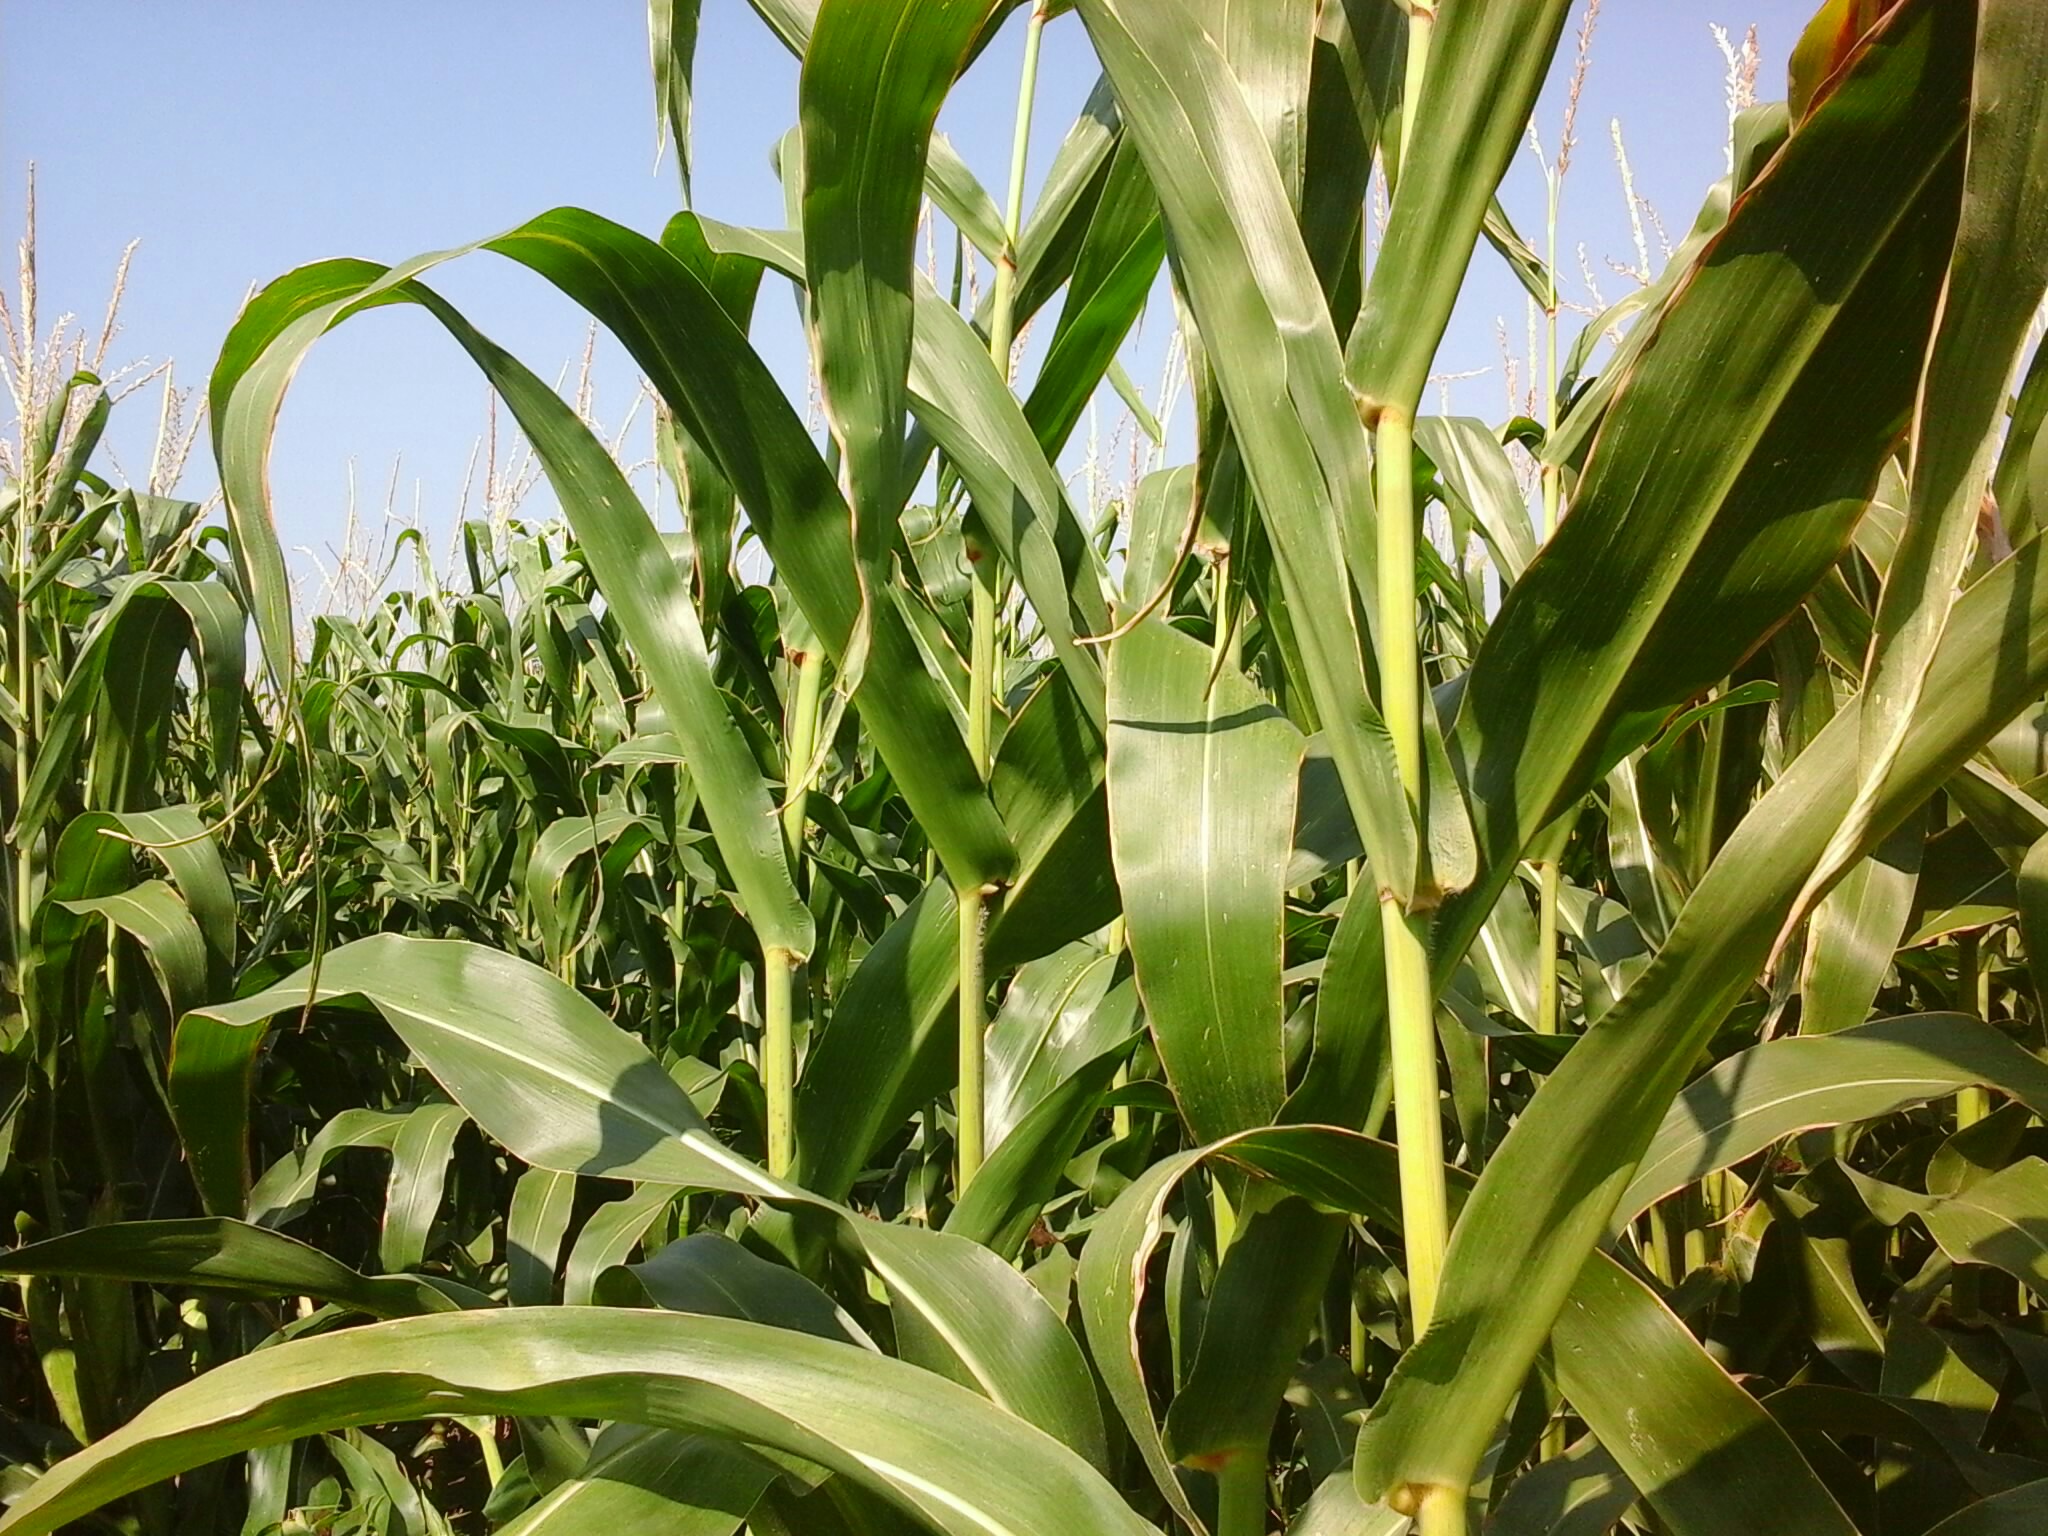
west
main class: Cropland
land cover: Maize
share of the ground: > 75 %
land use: Agriculture (excluding fallow land and kitchen gardens)
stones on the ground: < 10 %
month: August
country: HU
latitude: 47.1320
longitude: 18.3038
